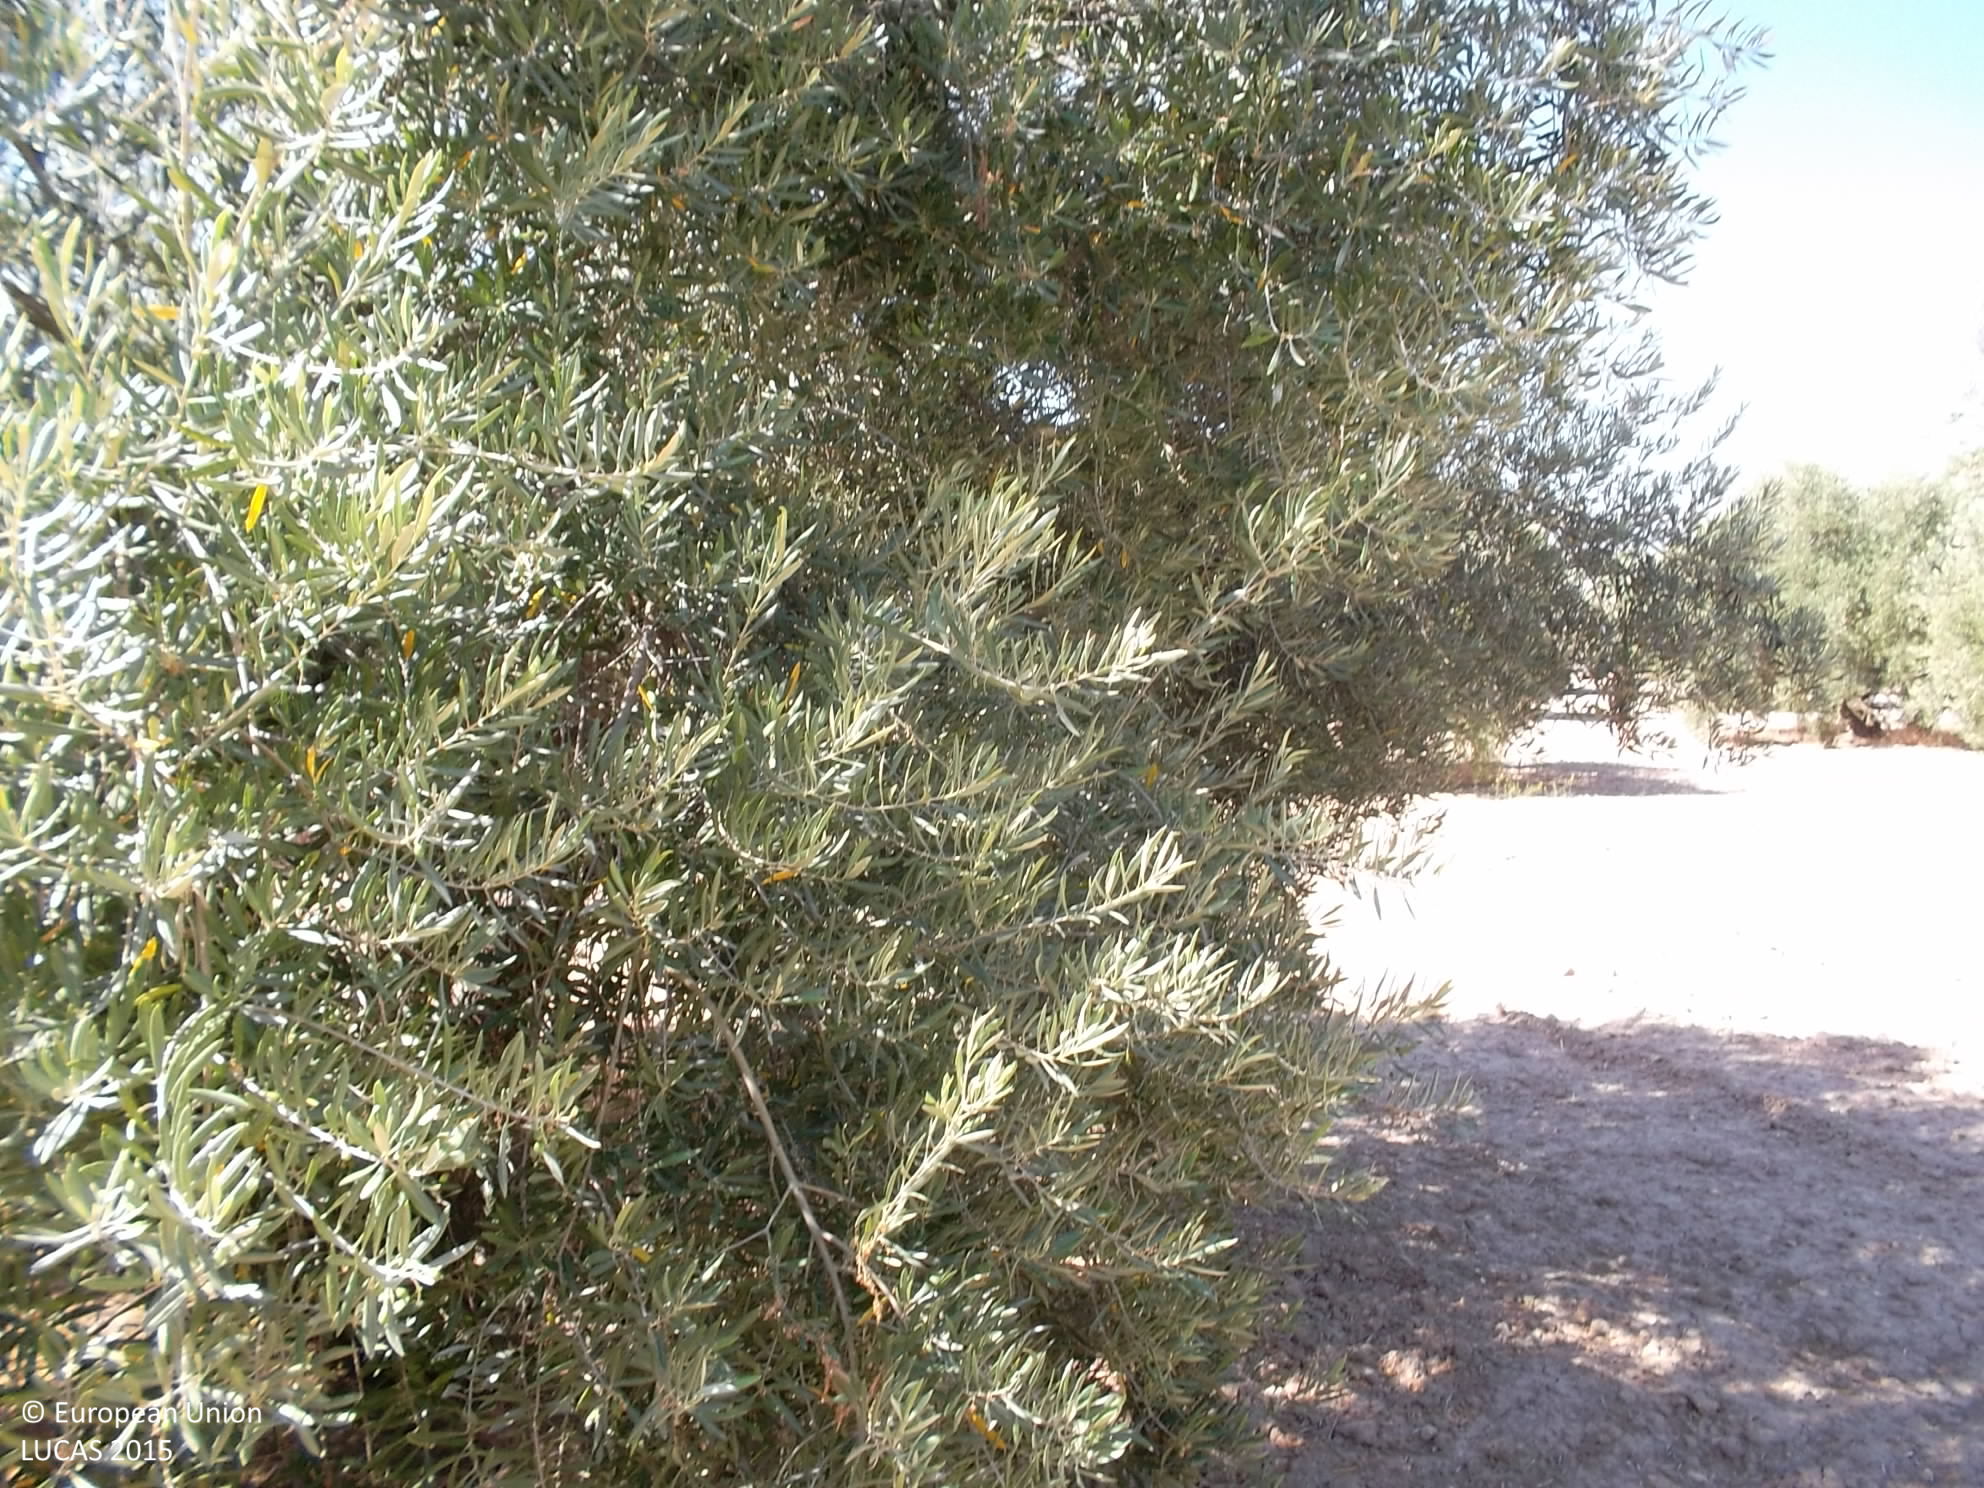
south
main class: Cropland
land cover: Olive groves
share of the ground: 25 - 50 %
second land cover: Other bare soil
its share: > 75 %
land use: Agriculture (excluding fallow land and kitchen gardens)
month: June
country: ES
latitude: 37.8507
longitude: -3.3283
